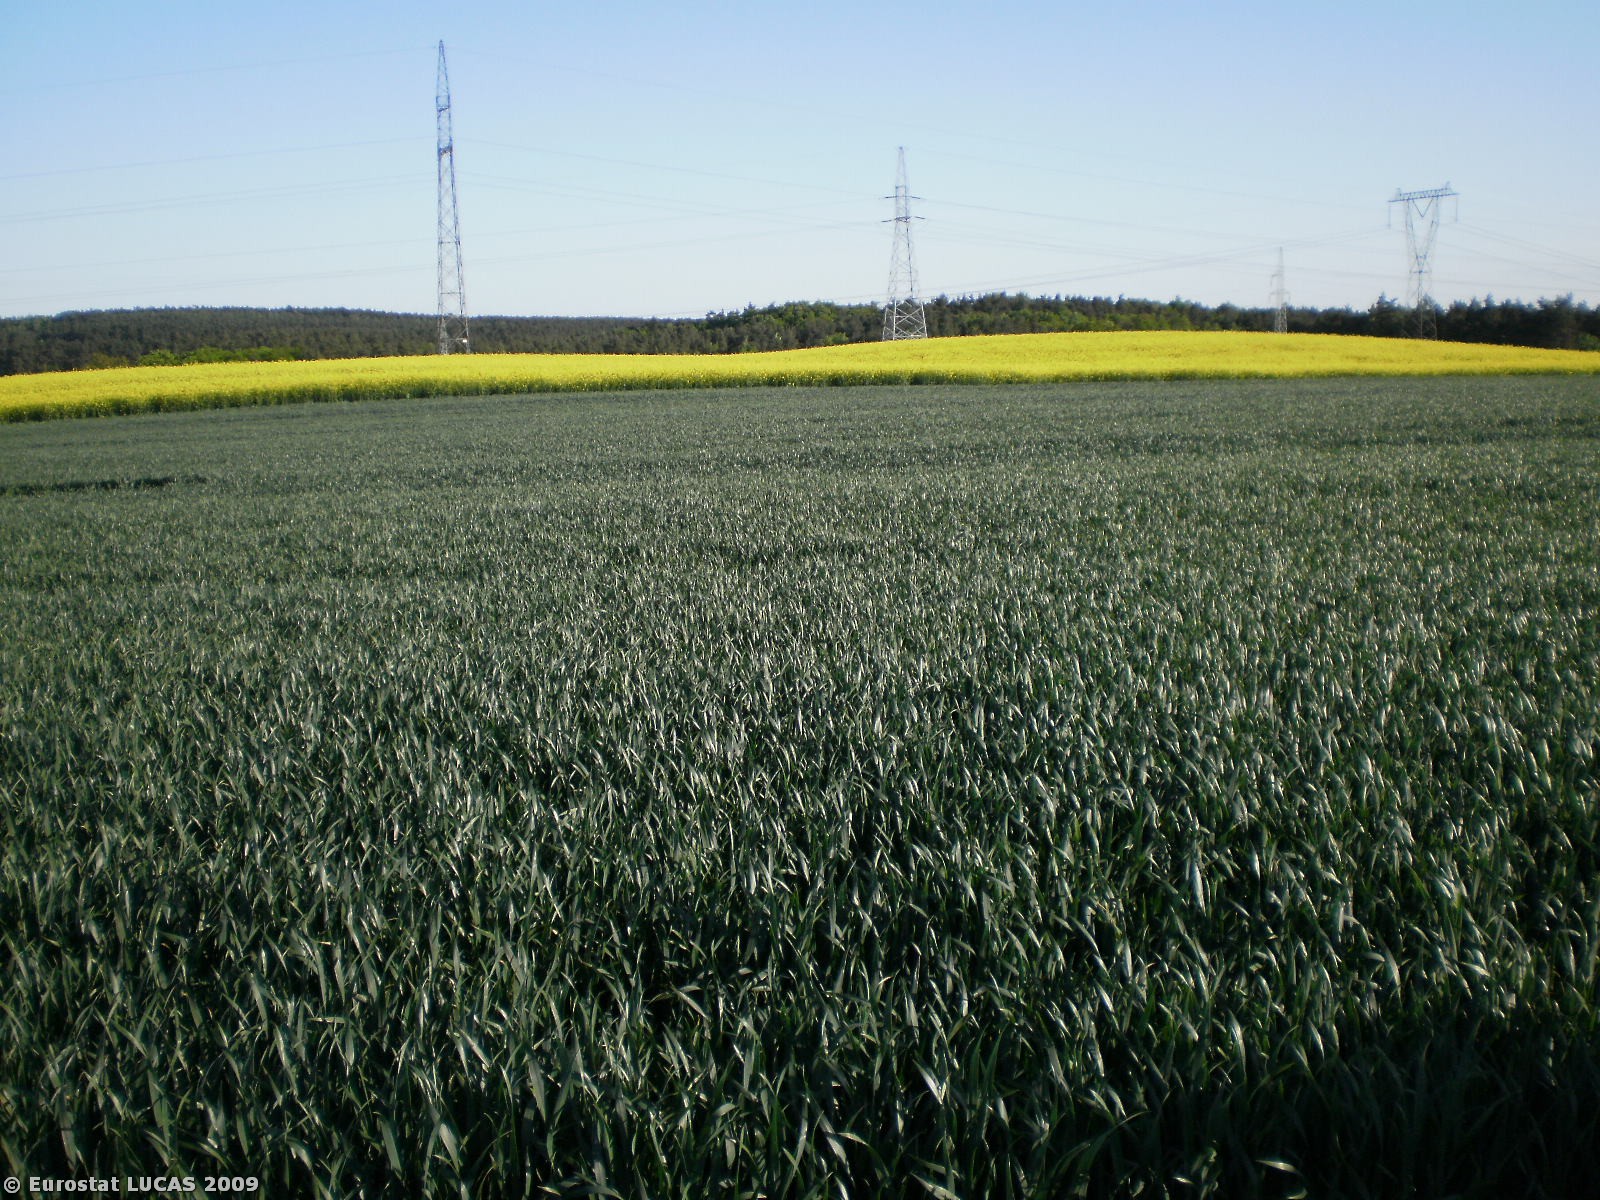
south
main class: Cropland
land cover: Common wheat
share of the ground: > 75 %
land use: Agriculture (excluding fallow land and kitchen gardens)
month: May
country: PL
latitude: 53.4587
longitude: 18.8315
